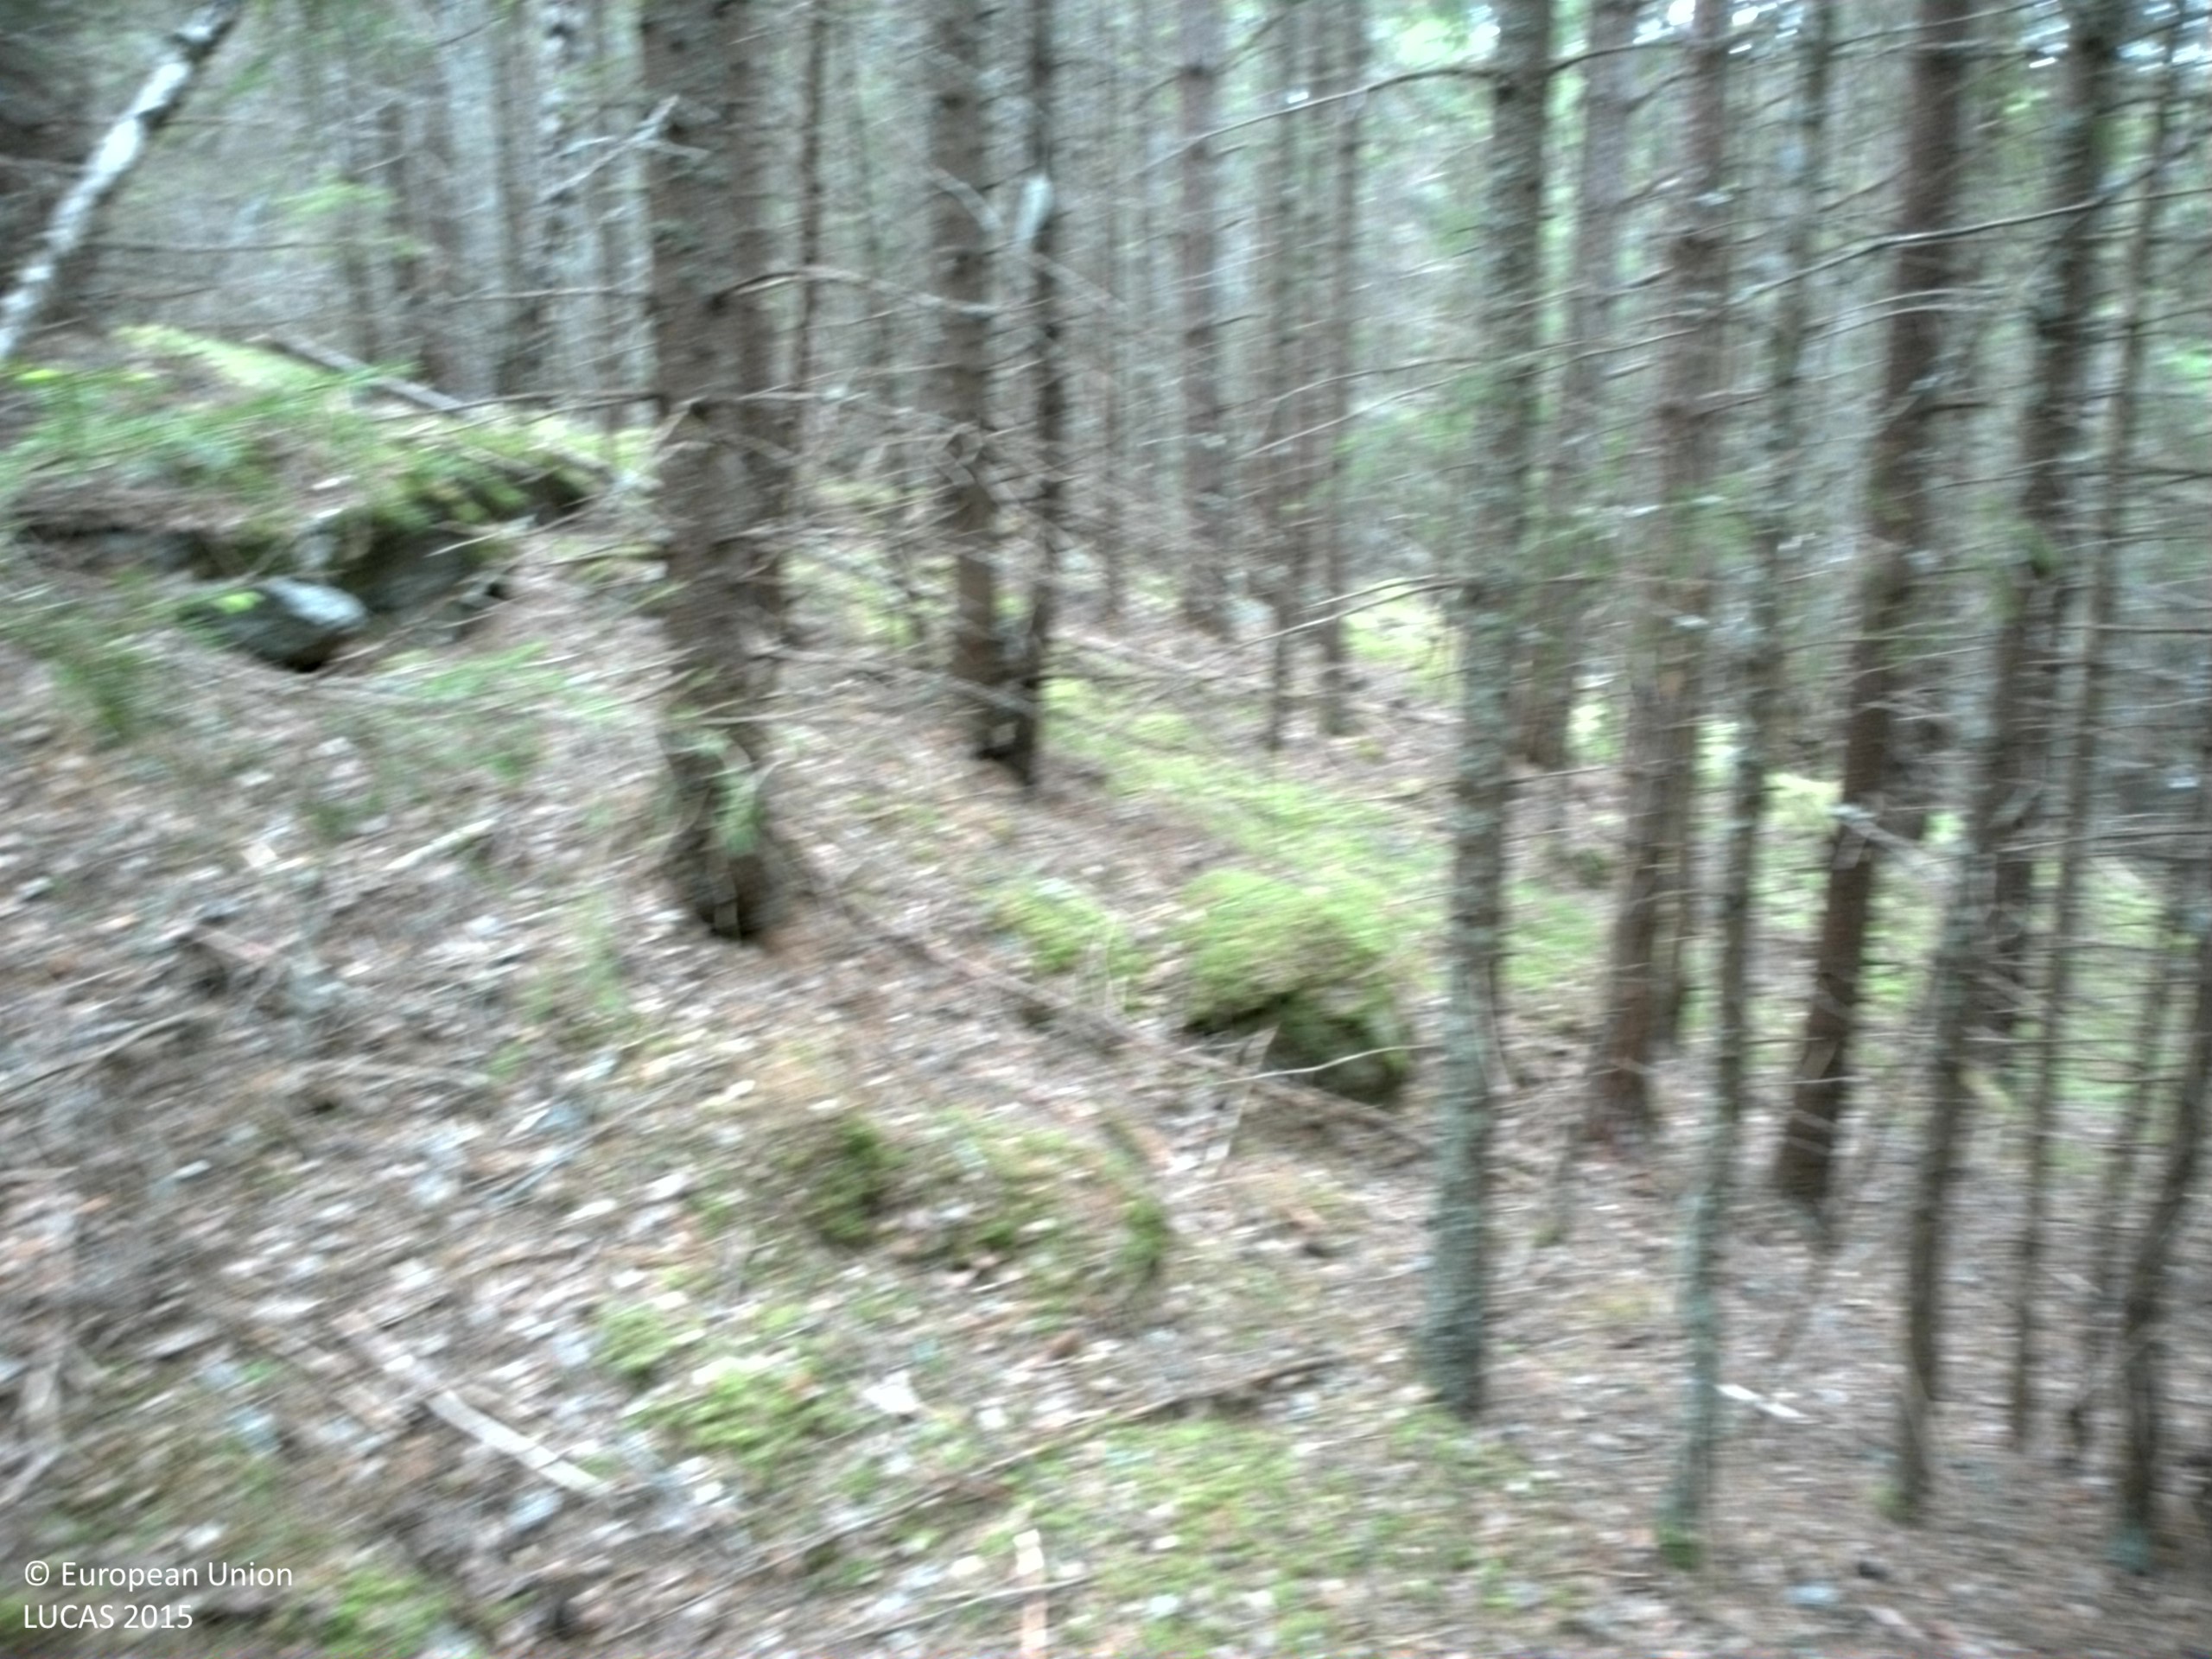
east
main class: Woodland
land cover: Spruce dominated coniferous woodland
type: boreal forest
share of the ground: > 75 %
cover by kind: coniferous forest trees 80 %, herbaceous plants 10 %, broadleaved forest trees 5 %, unconsolidated bare surface 5 %
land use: Forestry
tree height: > 5 m
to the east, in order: Spruce dominated coniferous woodland; Tracks; Spruce dominated mixed woodland; Inland fresh running water
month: June
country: SE
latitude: 62.9519
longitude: 17.8428
